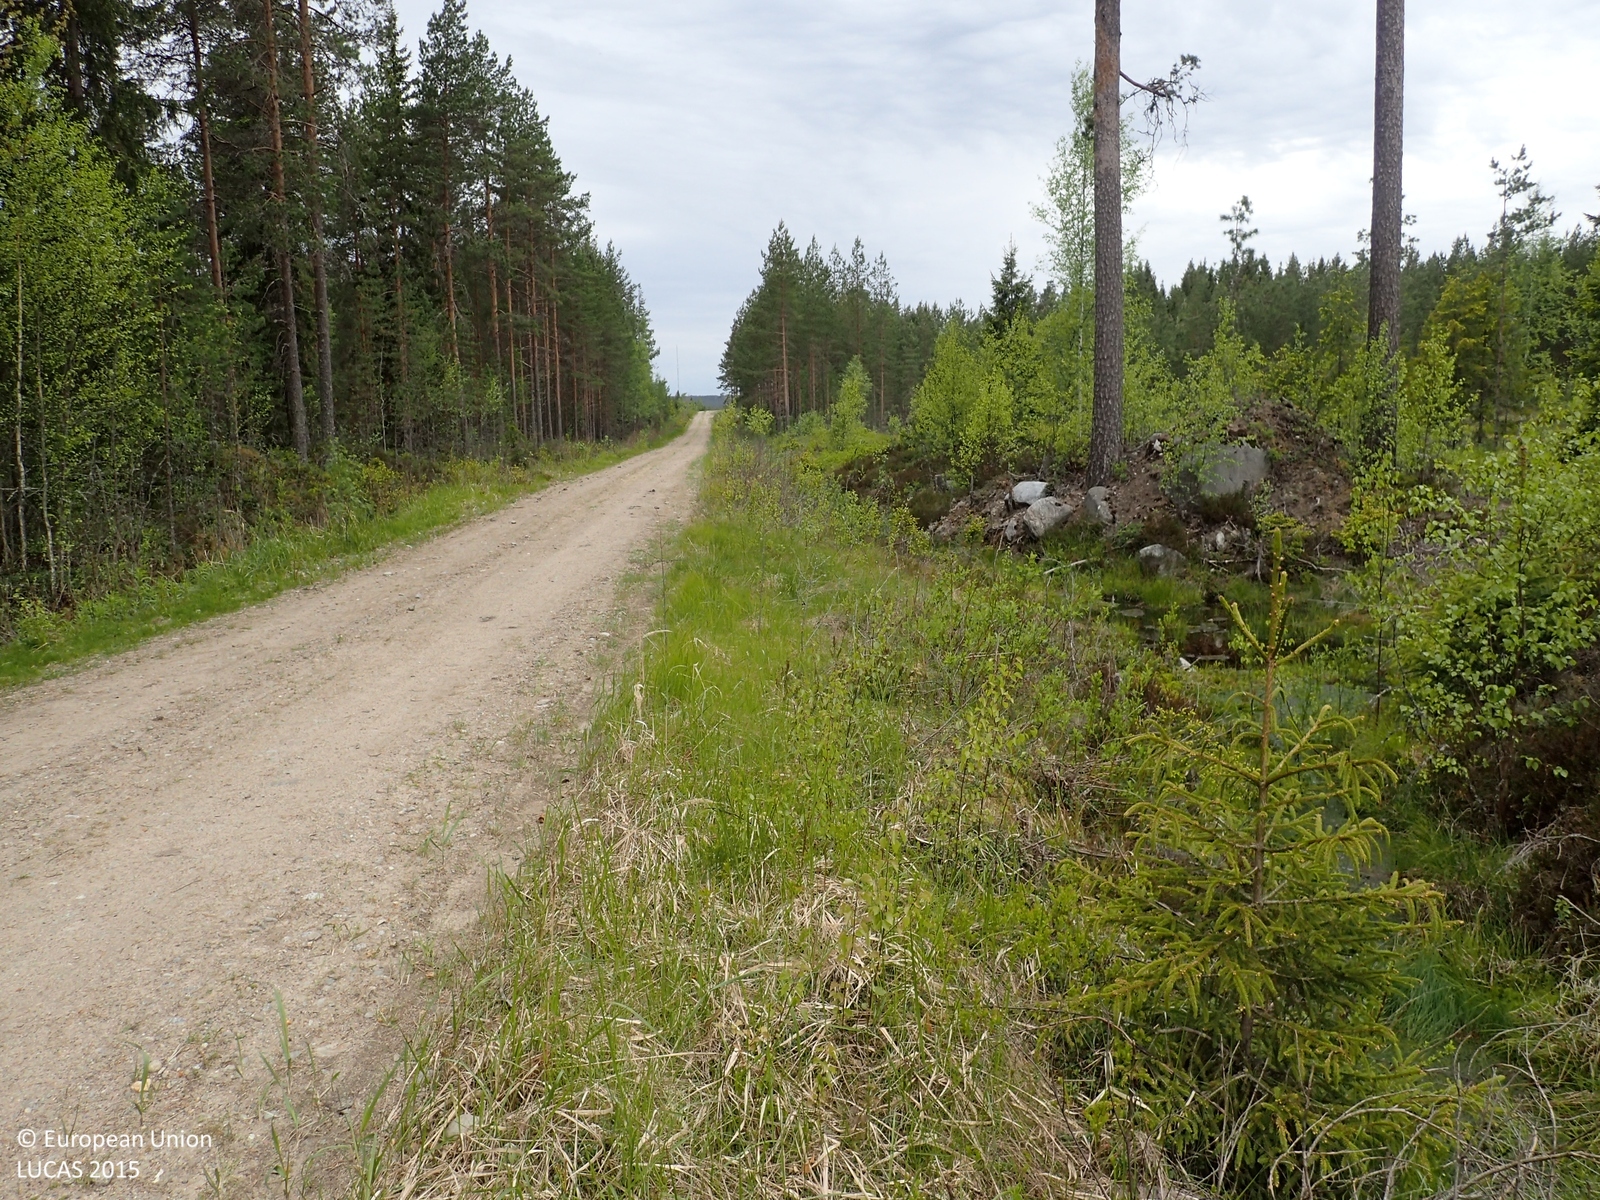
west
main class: Woodland
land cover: Pine dominated coniferous woodland
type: boreal forest
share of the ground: 25 - 50 %
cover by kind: herbaceous plants 40 %, shrubs 35 %, coniferous forest trees 20 %, broadleaved forest trees 5 %
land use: Forestry
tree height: > 5 m
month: June
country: FI
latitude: 62.2789
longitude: 21.7447
